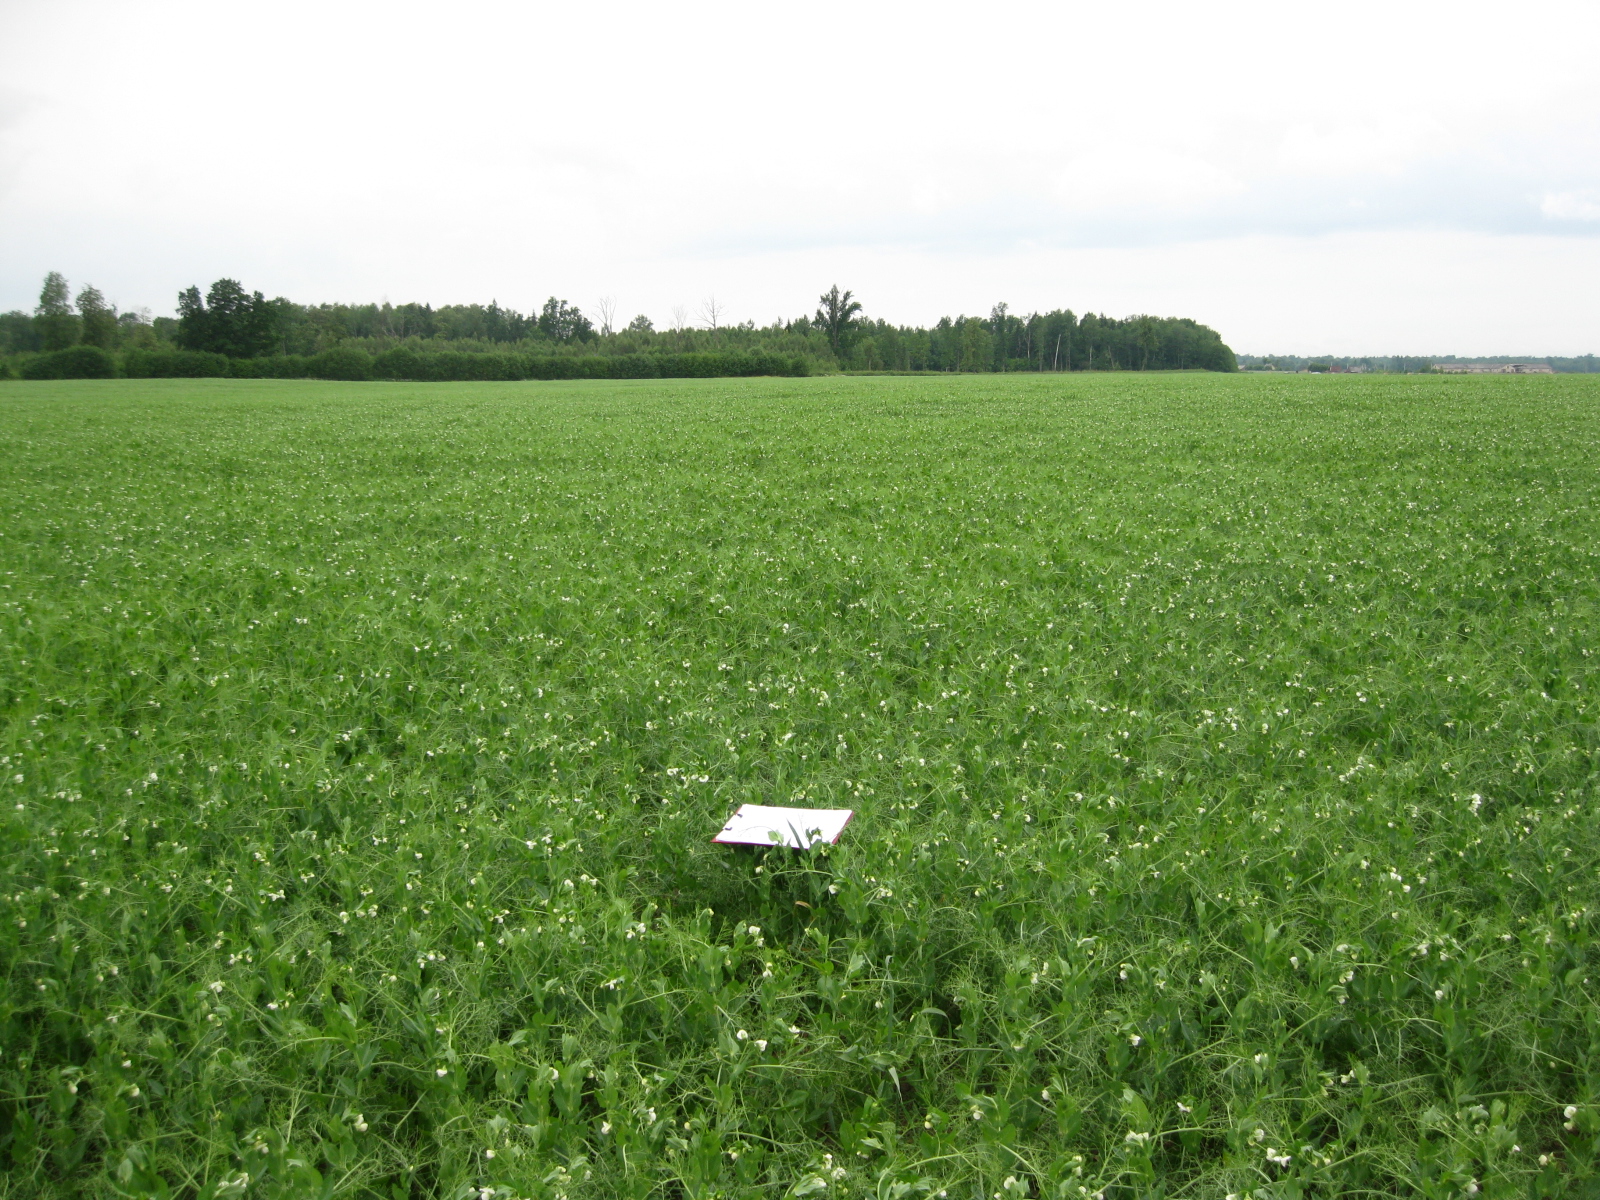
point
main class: Cropland
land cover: Dry pulses
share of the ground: > 75 %
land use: Agriculture (excluding fallow land and kitchen gardens)
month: June
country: LT
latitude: 55.1157
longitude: 24.0610
